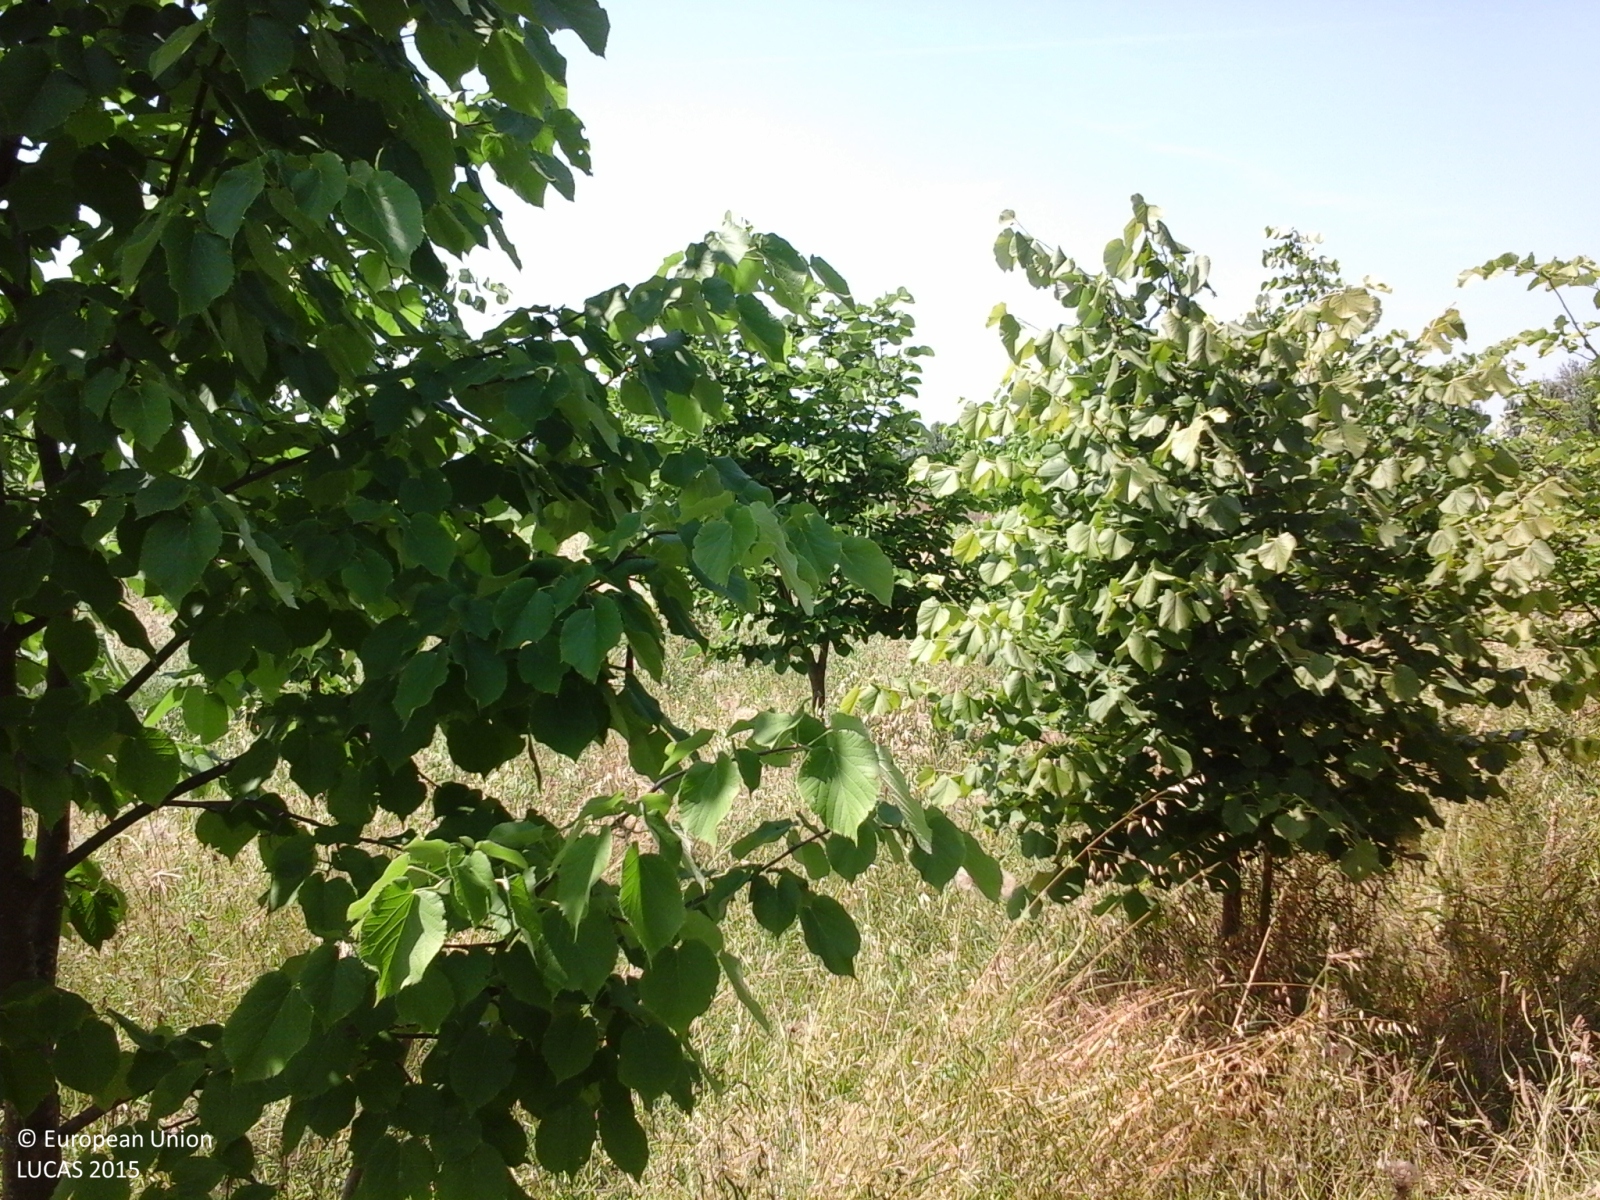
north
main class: Cropland
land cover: Nurseries
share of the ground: 50 - 75 %
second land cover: Spontaneously vegetated surfaces
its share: > 75 %
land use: Agriculture (excluding fallow land and kitchen gardens)
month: June
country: IT
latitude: 44.5060
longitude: 11.1923
